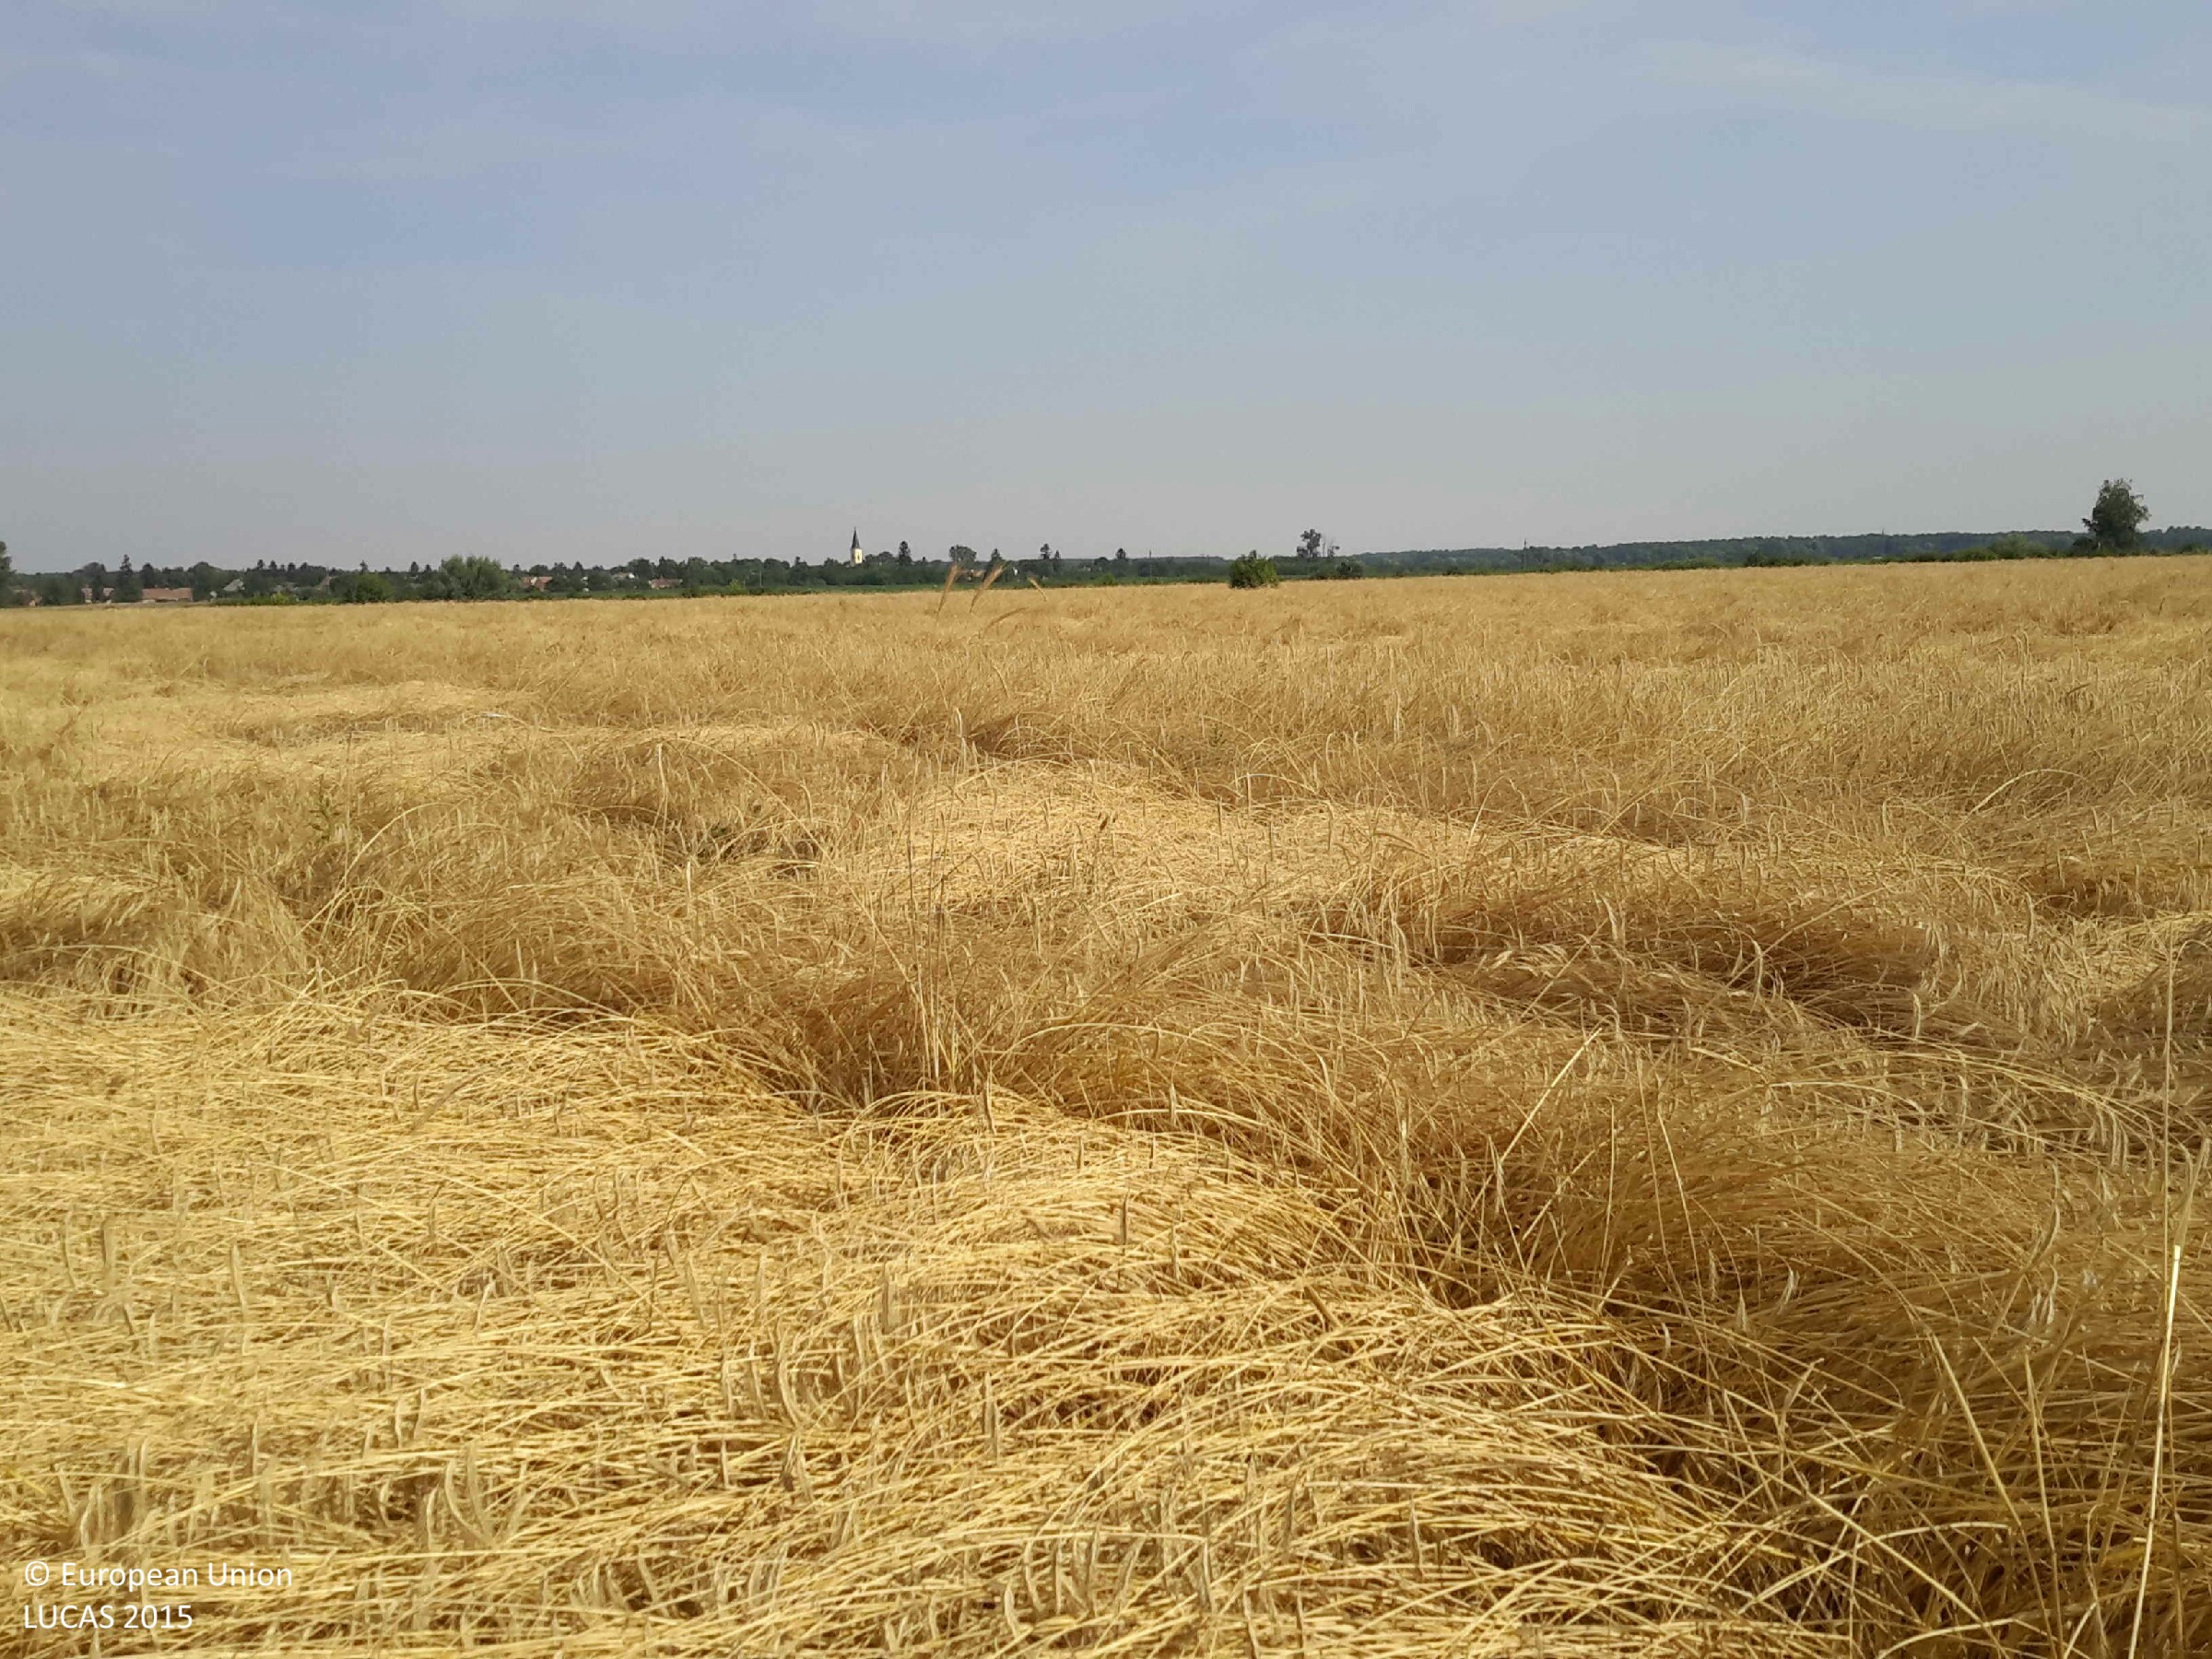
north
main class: Cropland
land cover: Common wheat
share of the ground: > 75 %
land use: Agriculture (excluding fallow land and kitchen gardens)
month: July
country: HU
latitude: 47.3184
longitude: 17.2164
